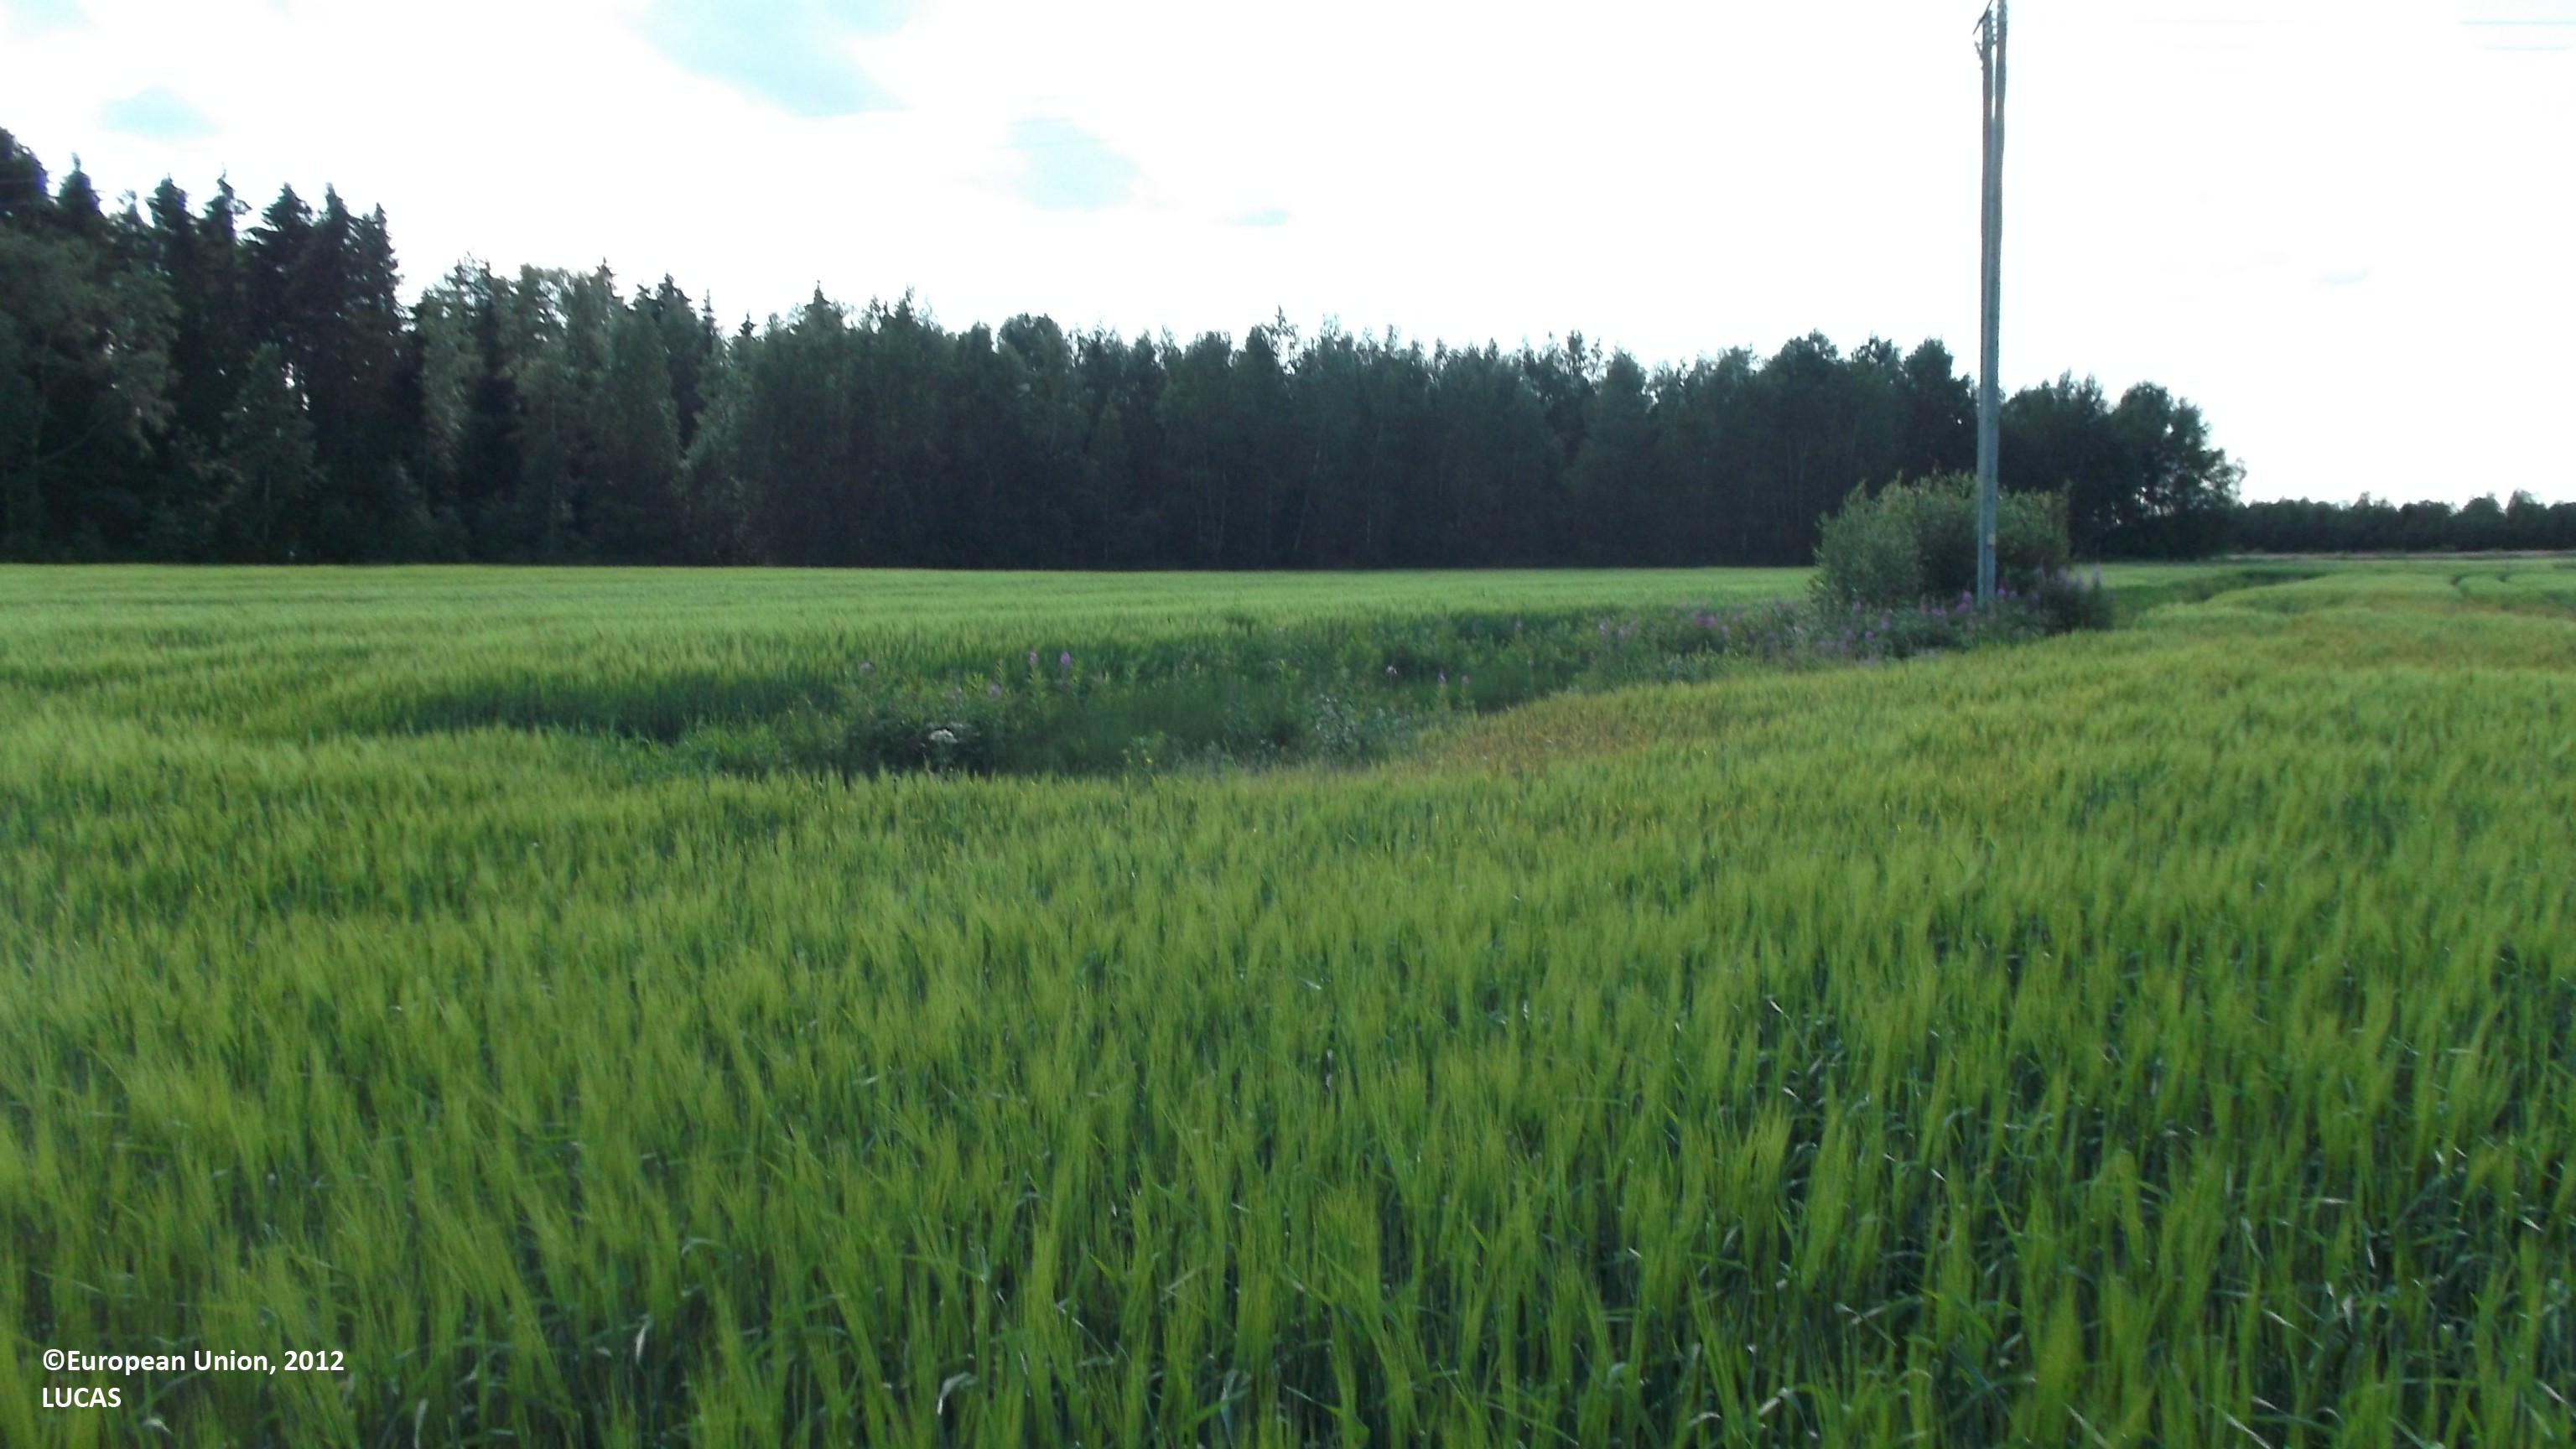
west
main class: Cropland
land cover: Barley
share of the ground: > 75 %
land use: Agriculture (excluding fallow land and kitchen gardens)
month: July
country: FI
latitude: 63.5771
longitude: 22.8823
